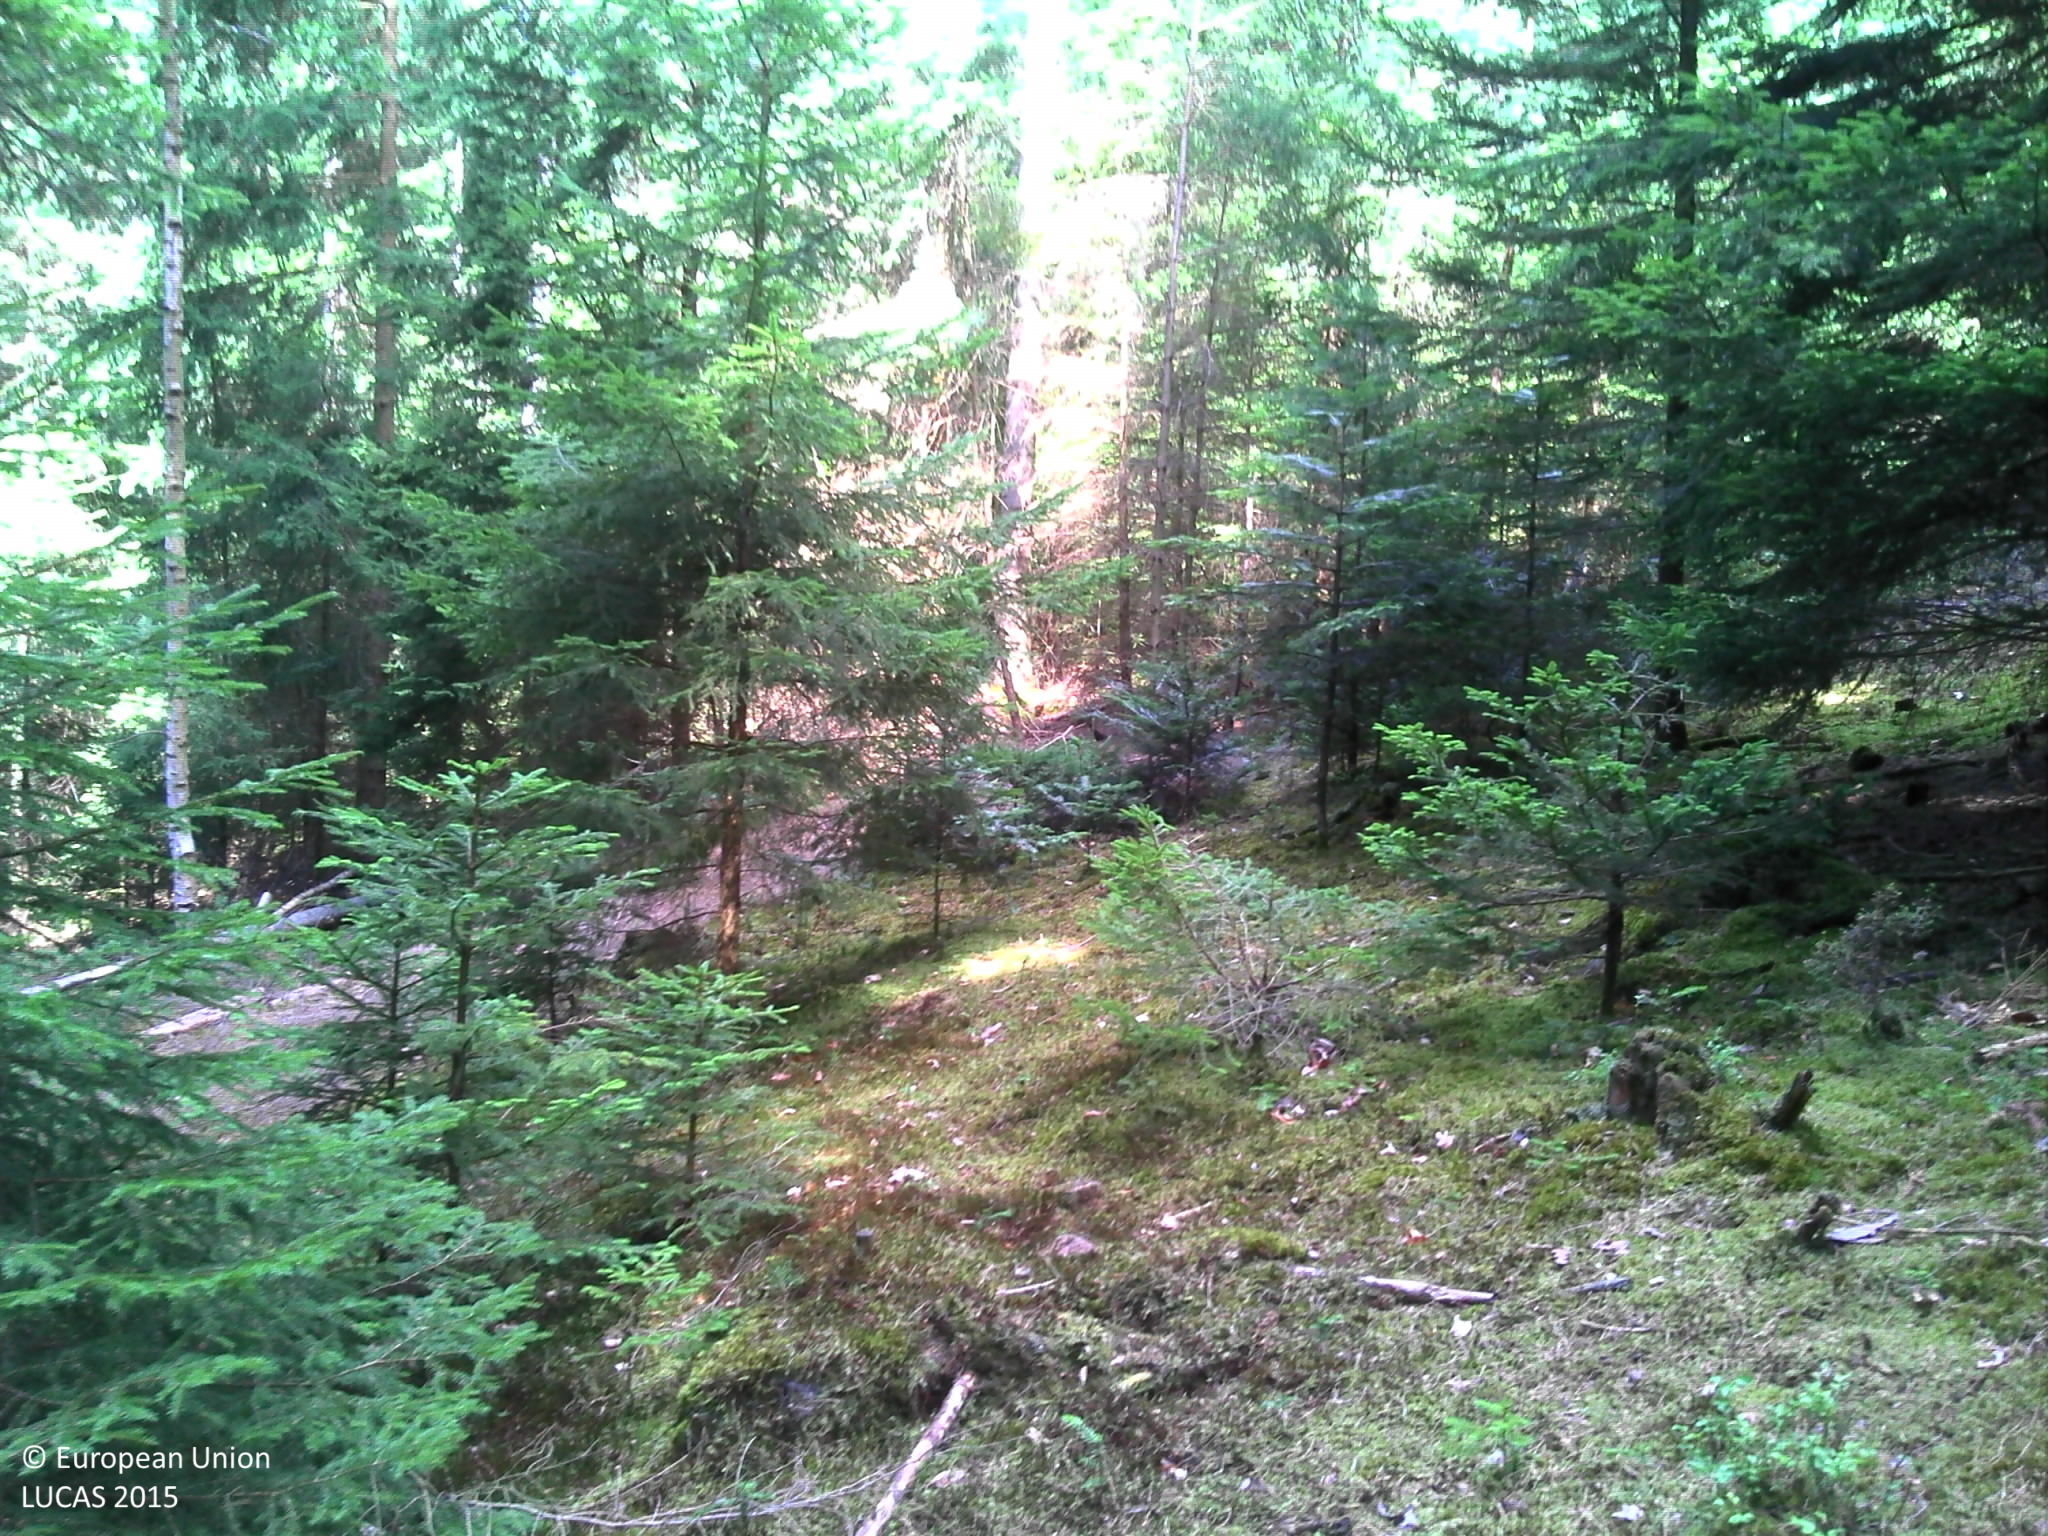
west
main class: Woodland
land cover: Other coniferous woodland
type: alpine coniferous forest
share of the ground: > 75 %
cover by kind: coniferous forest trees 90 %, lichens and mosses 10 %
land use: Forestry
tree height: > 5 m
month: July
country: FR
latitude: 48.6406
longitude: 7.3000
